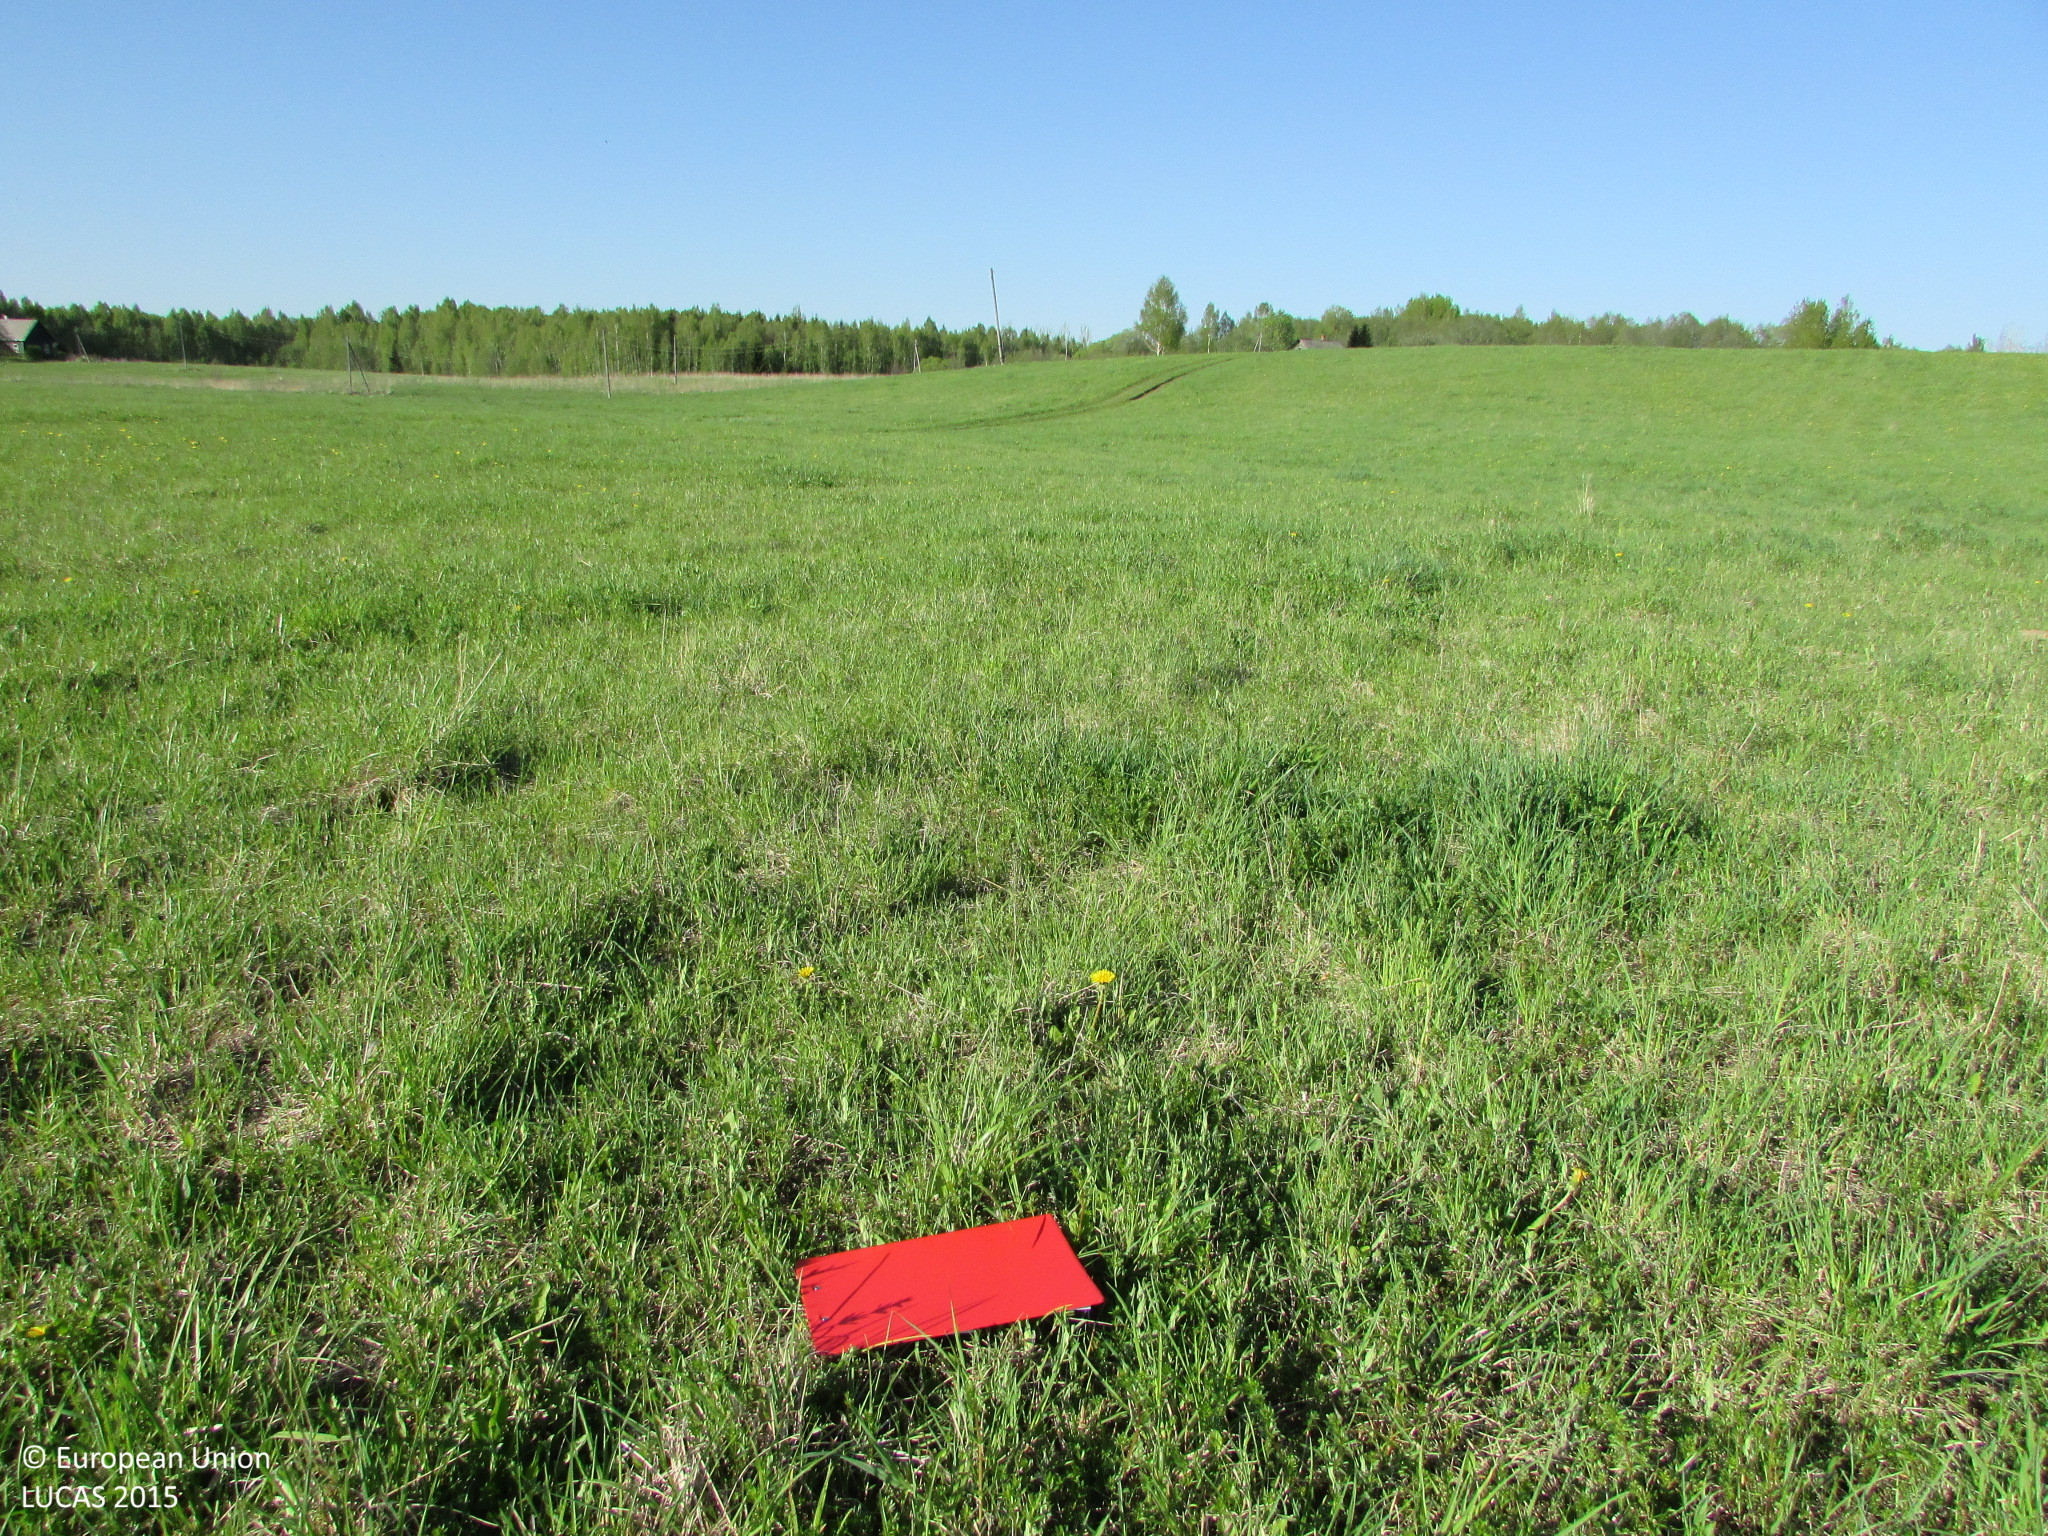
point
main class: Grassland
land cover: Grassland without tree/shrub cover
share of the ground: > 75 %
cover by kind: herbaceous plants 100 %
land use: Agriculture (excluding fallow land and kitchen gardens)
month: May
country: LV
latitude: 55.9019
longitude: 27.5701
